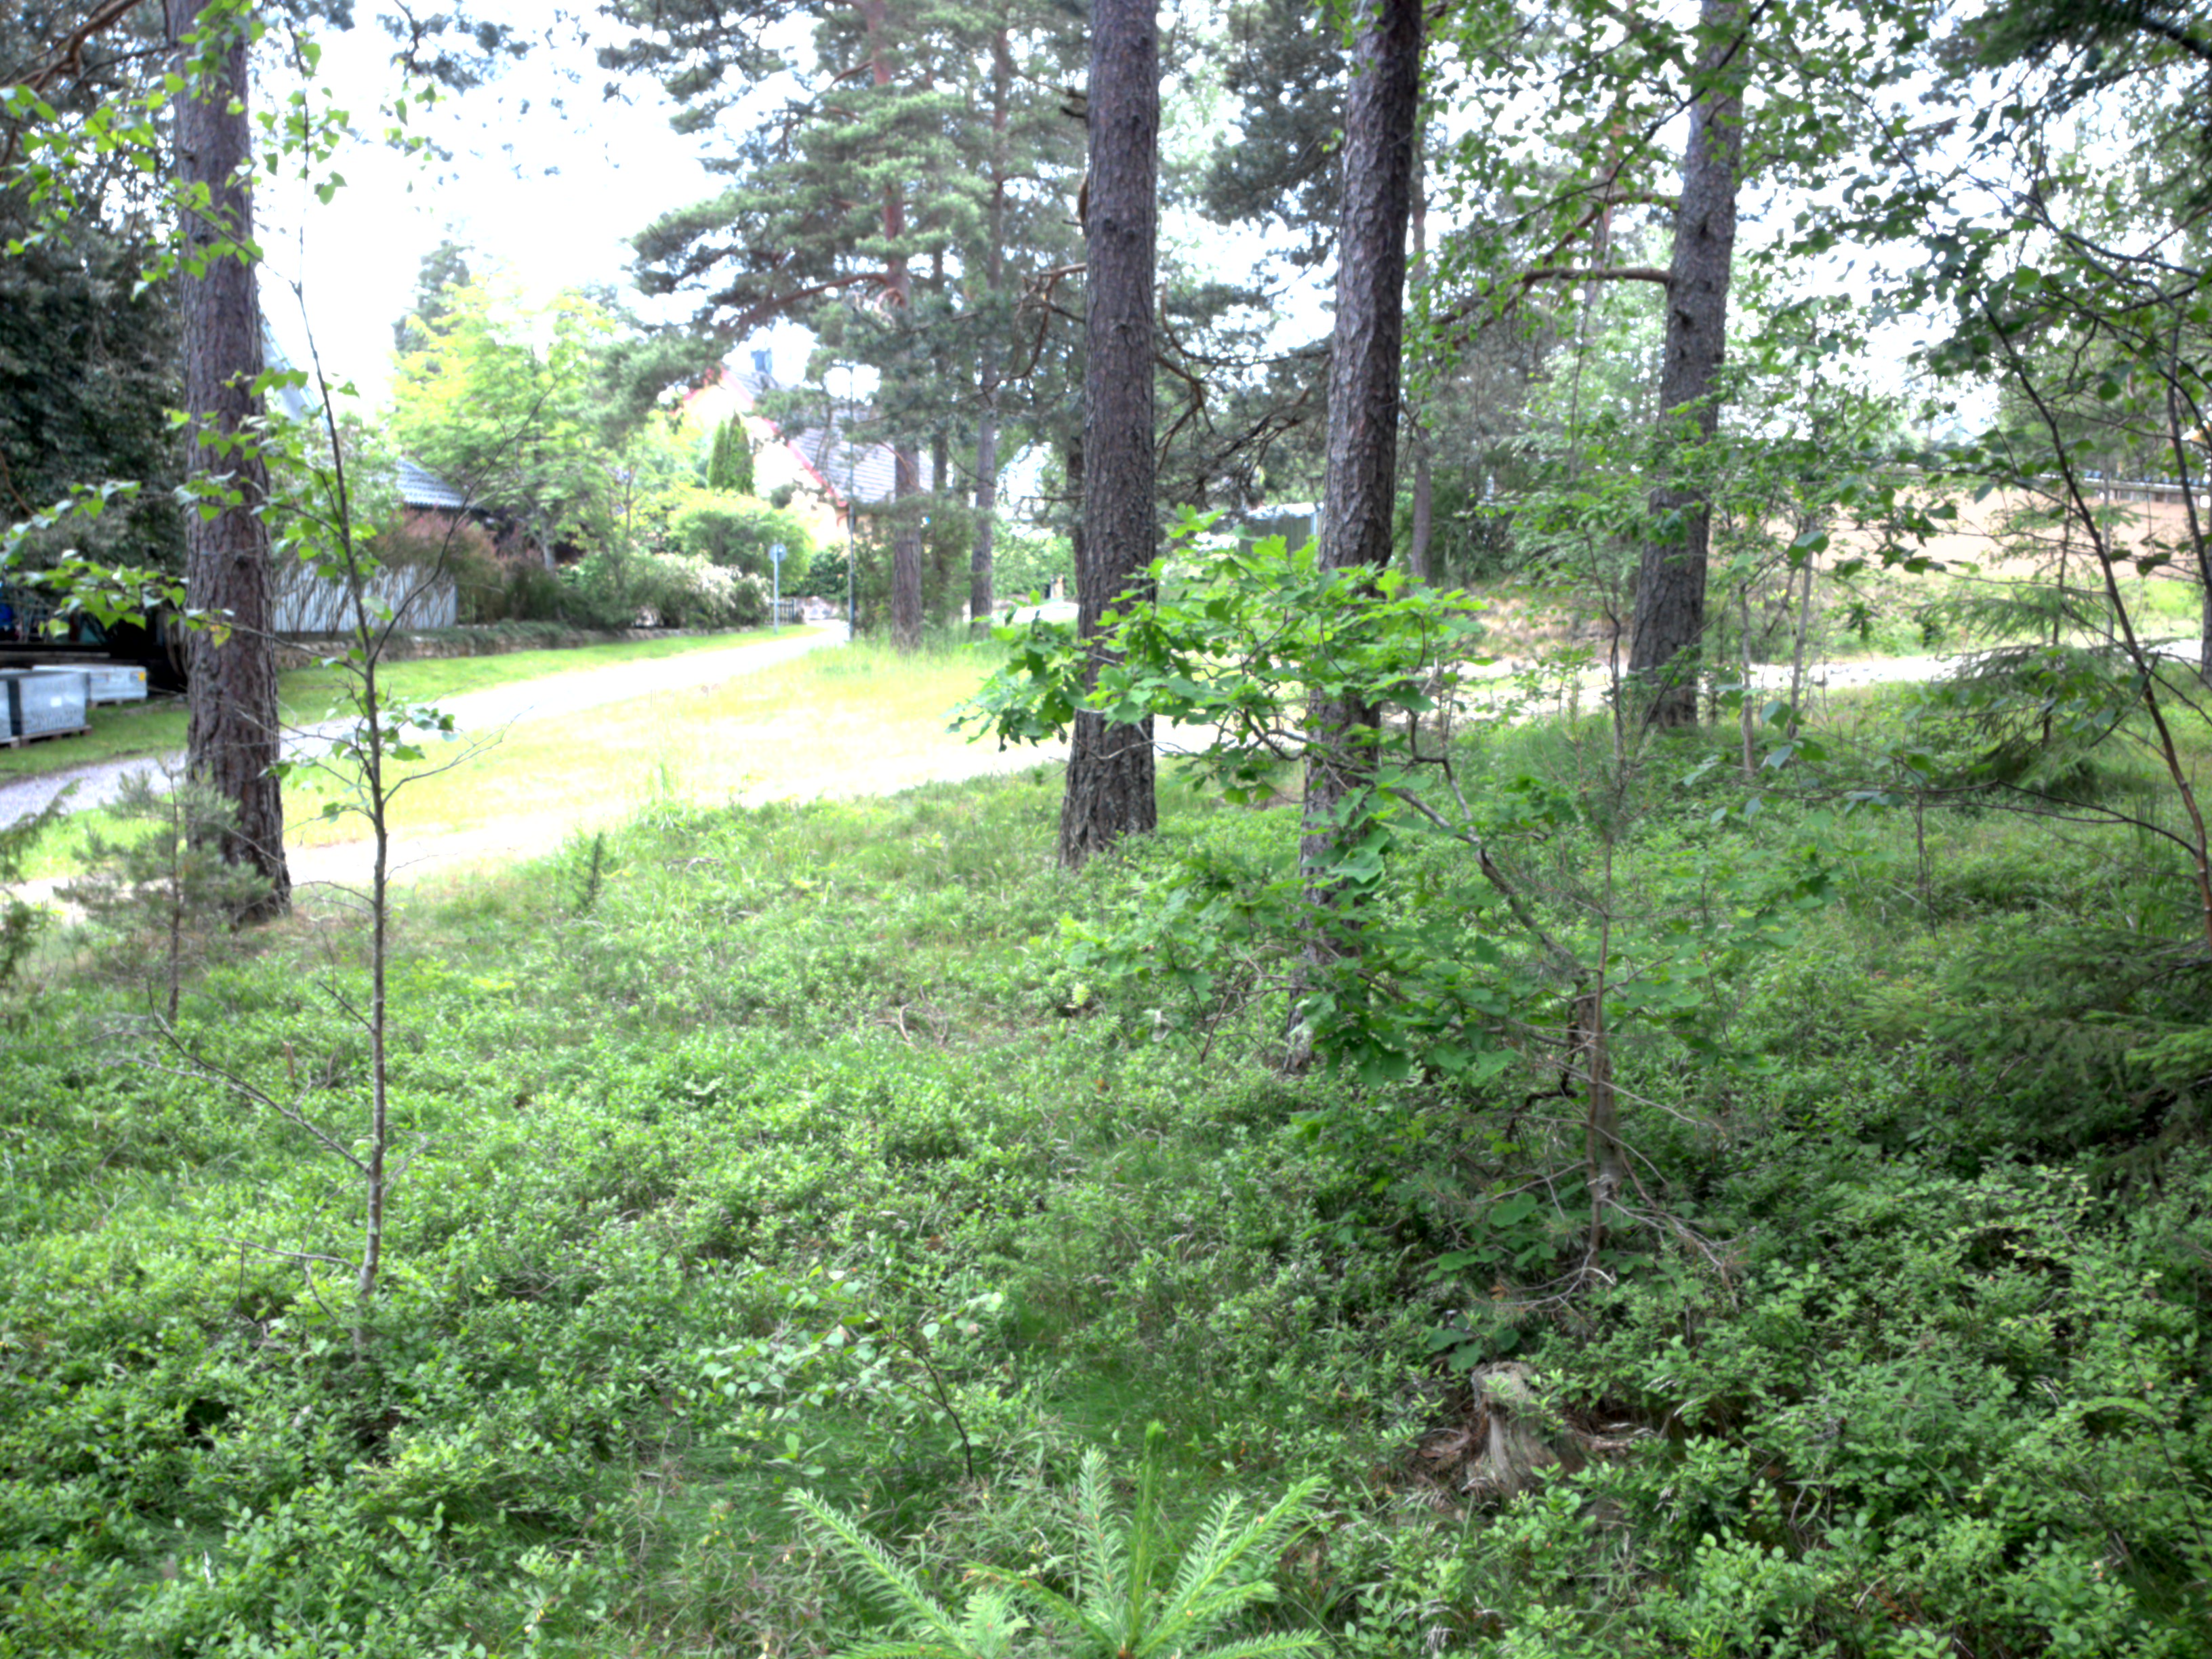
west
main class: Woodland
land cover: Pine dominated coniferous woodland
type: boreal forest
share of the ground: 50 - 75 %
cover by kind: coniferous forest trees 70 %, shrubs 25 %, herbaceous plants 5 %
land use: Forestry
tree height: > 5 m
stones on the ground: < 10 %
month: June
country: SE
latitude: 59.2563
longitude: 17.5204
